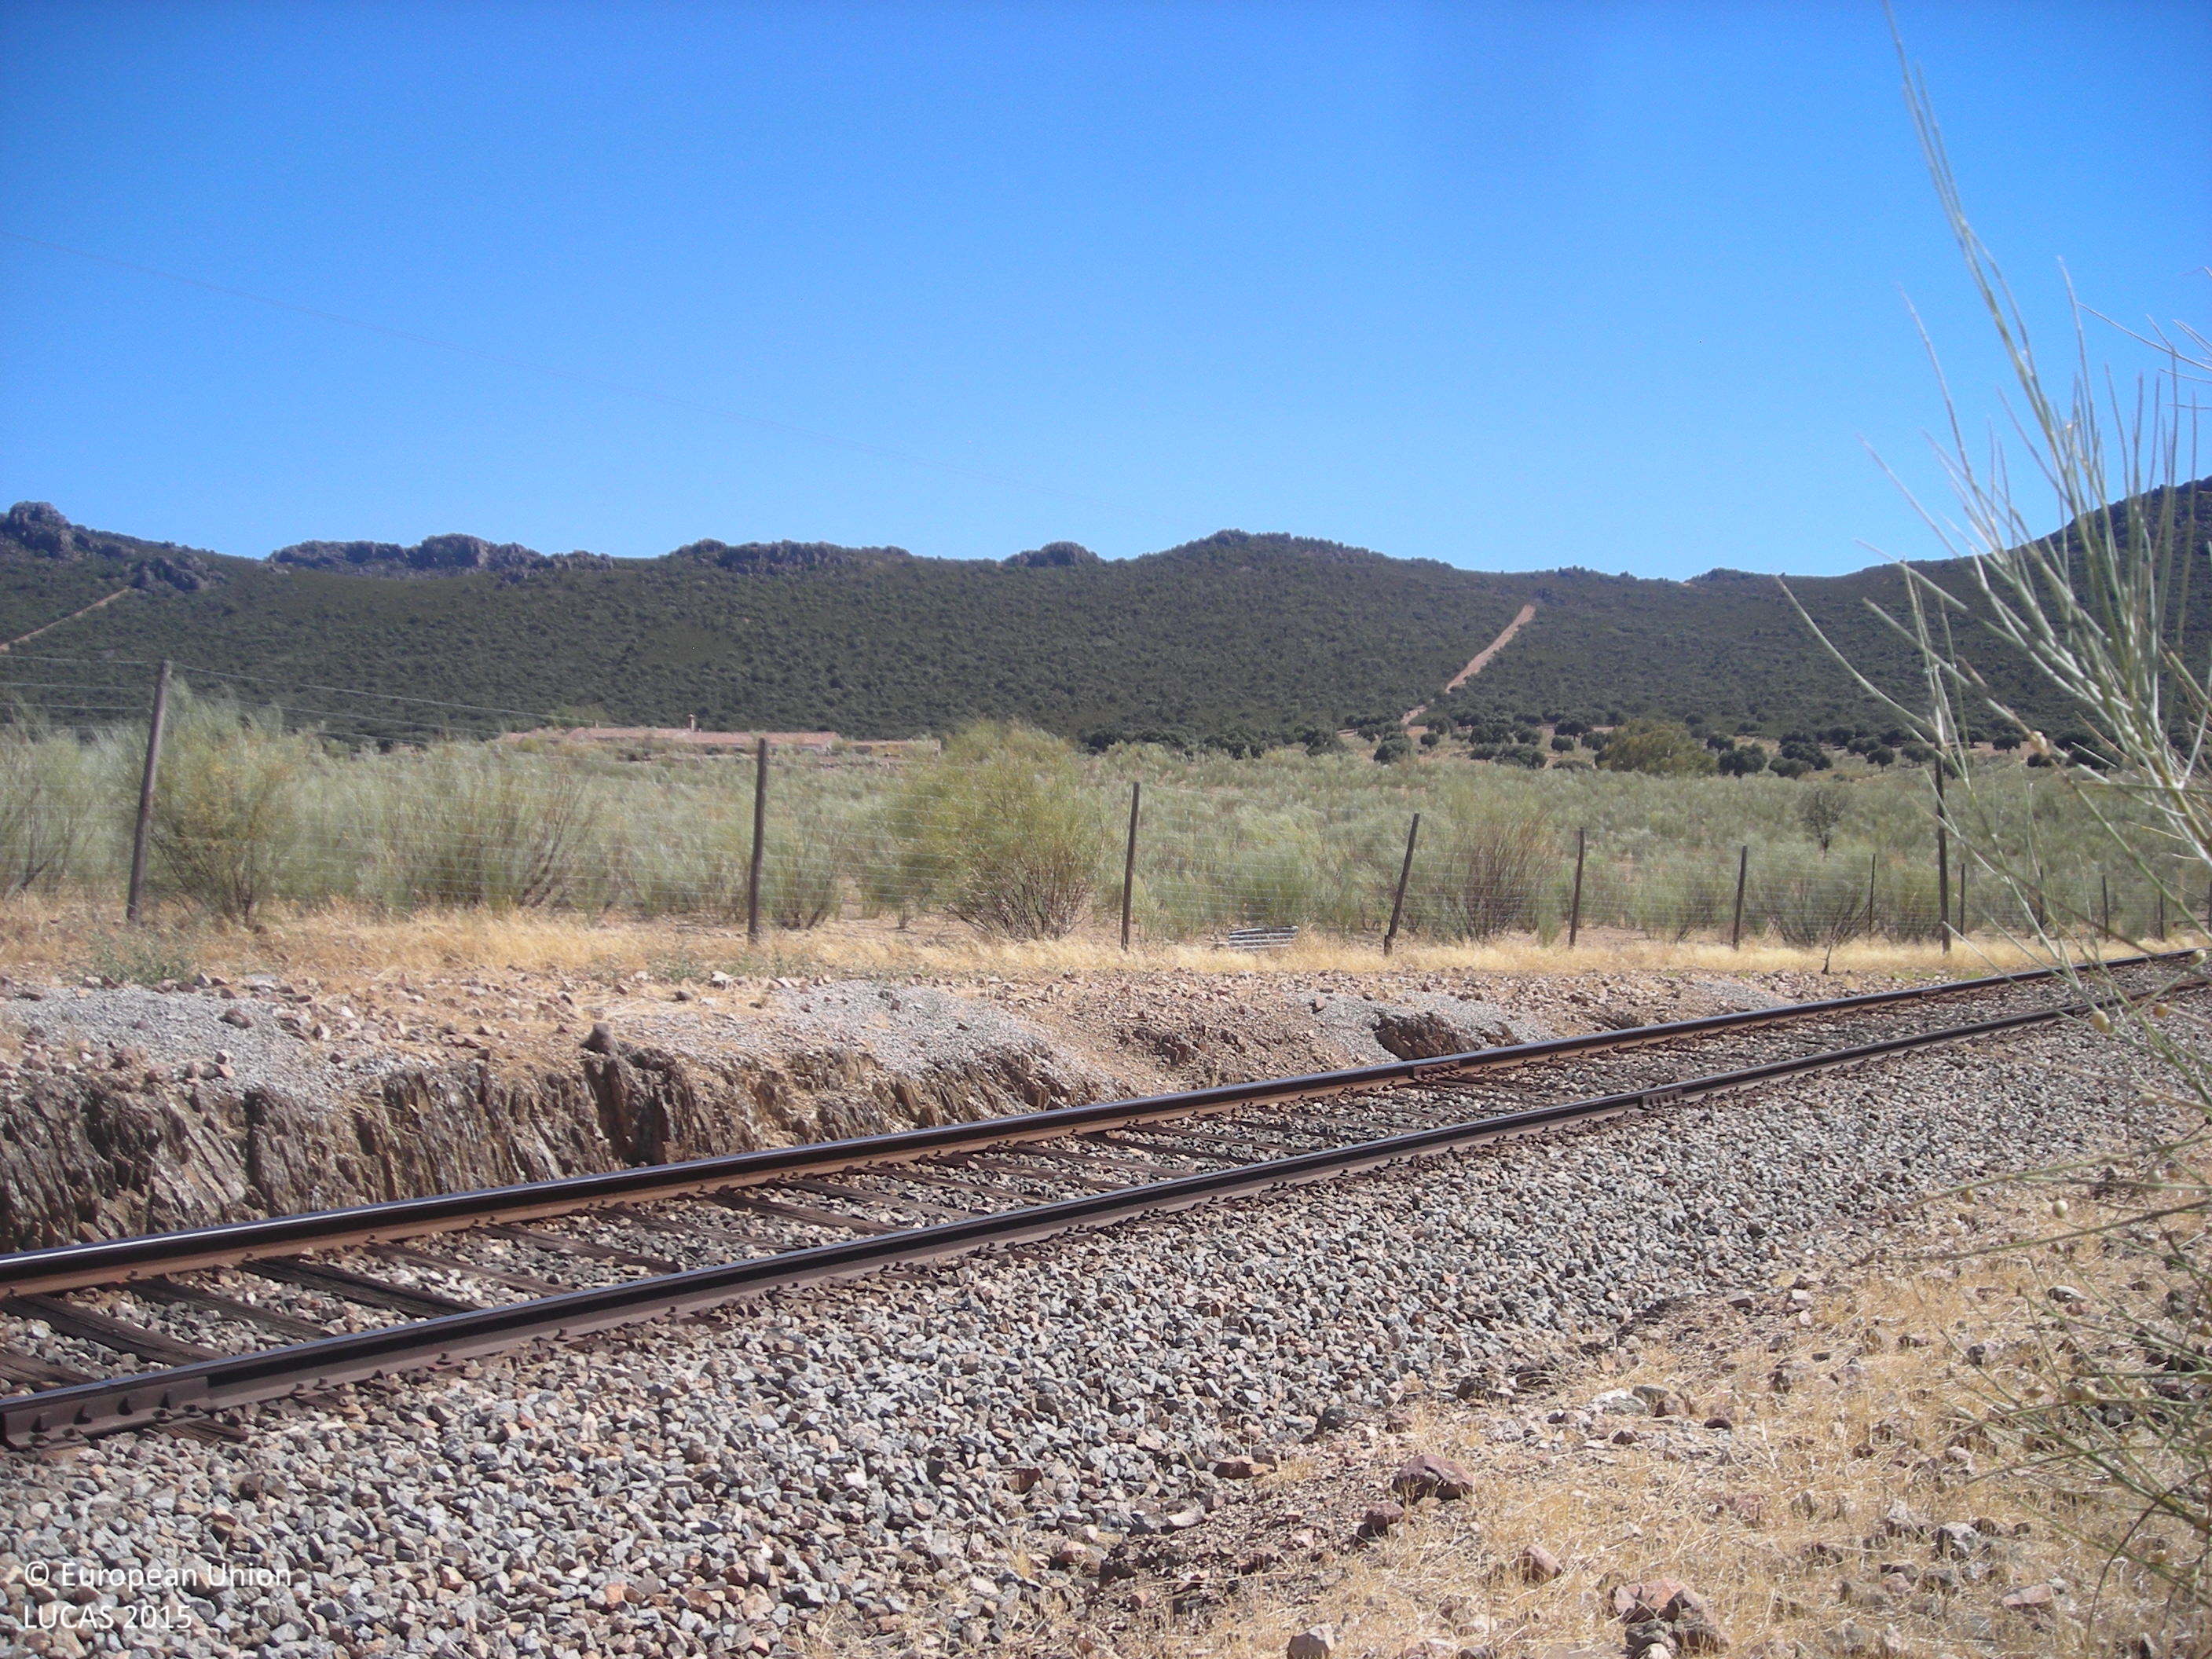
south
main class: Shrubland
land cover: Shrubland without tree cover
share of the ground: > 75 %
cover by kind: shrubs 50 %, herbaceous plants 50 %
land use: Agriculture (excluding fallow land and kitchen gardens)
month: July
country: ES
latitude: 38.6961
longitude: -5.3862
